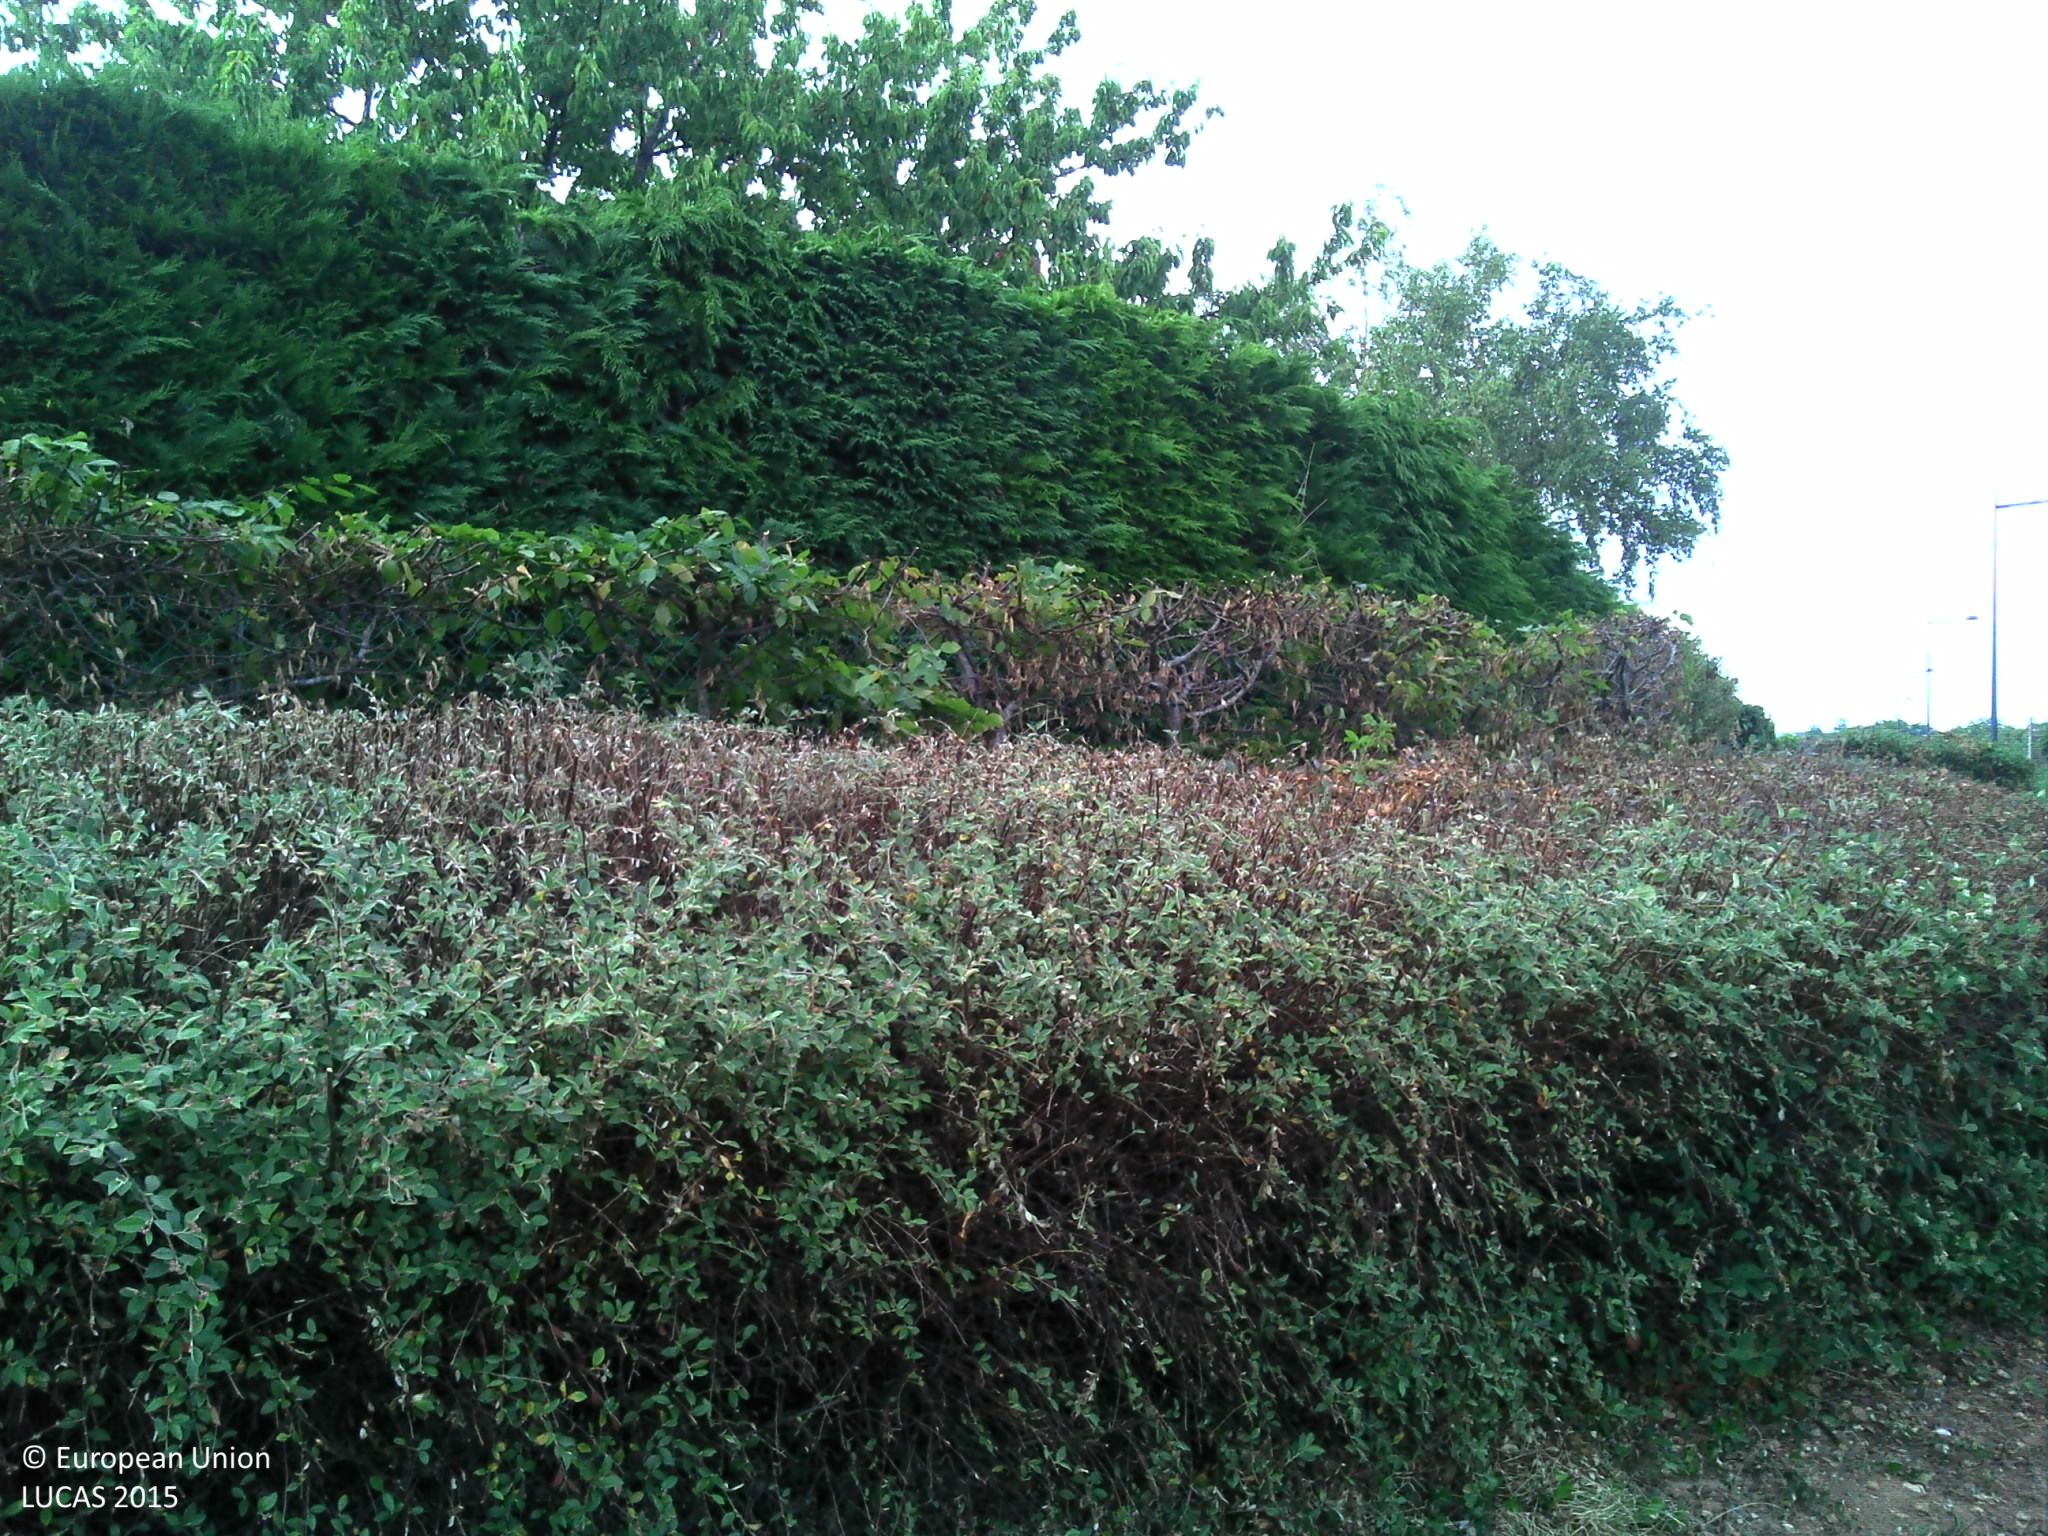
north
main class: Grassland
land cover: Grassland without tree/shrub cover
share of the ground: > 75 %
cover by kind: herbaceous plants 100 %
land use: Semi-natural and natural areas not in use
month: June
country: FR
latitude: 49.2665
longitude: 1.2258
